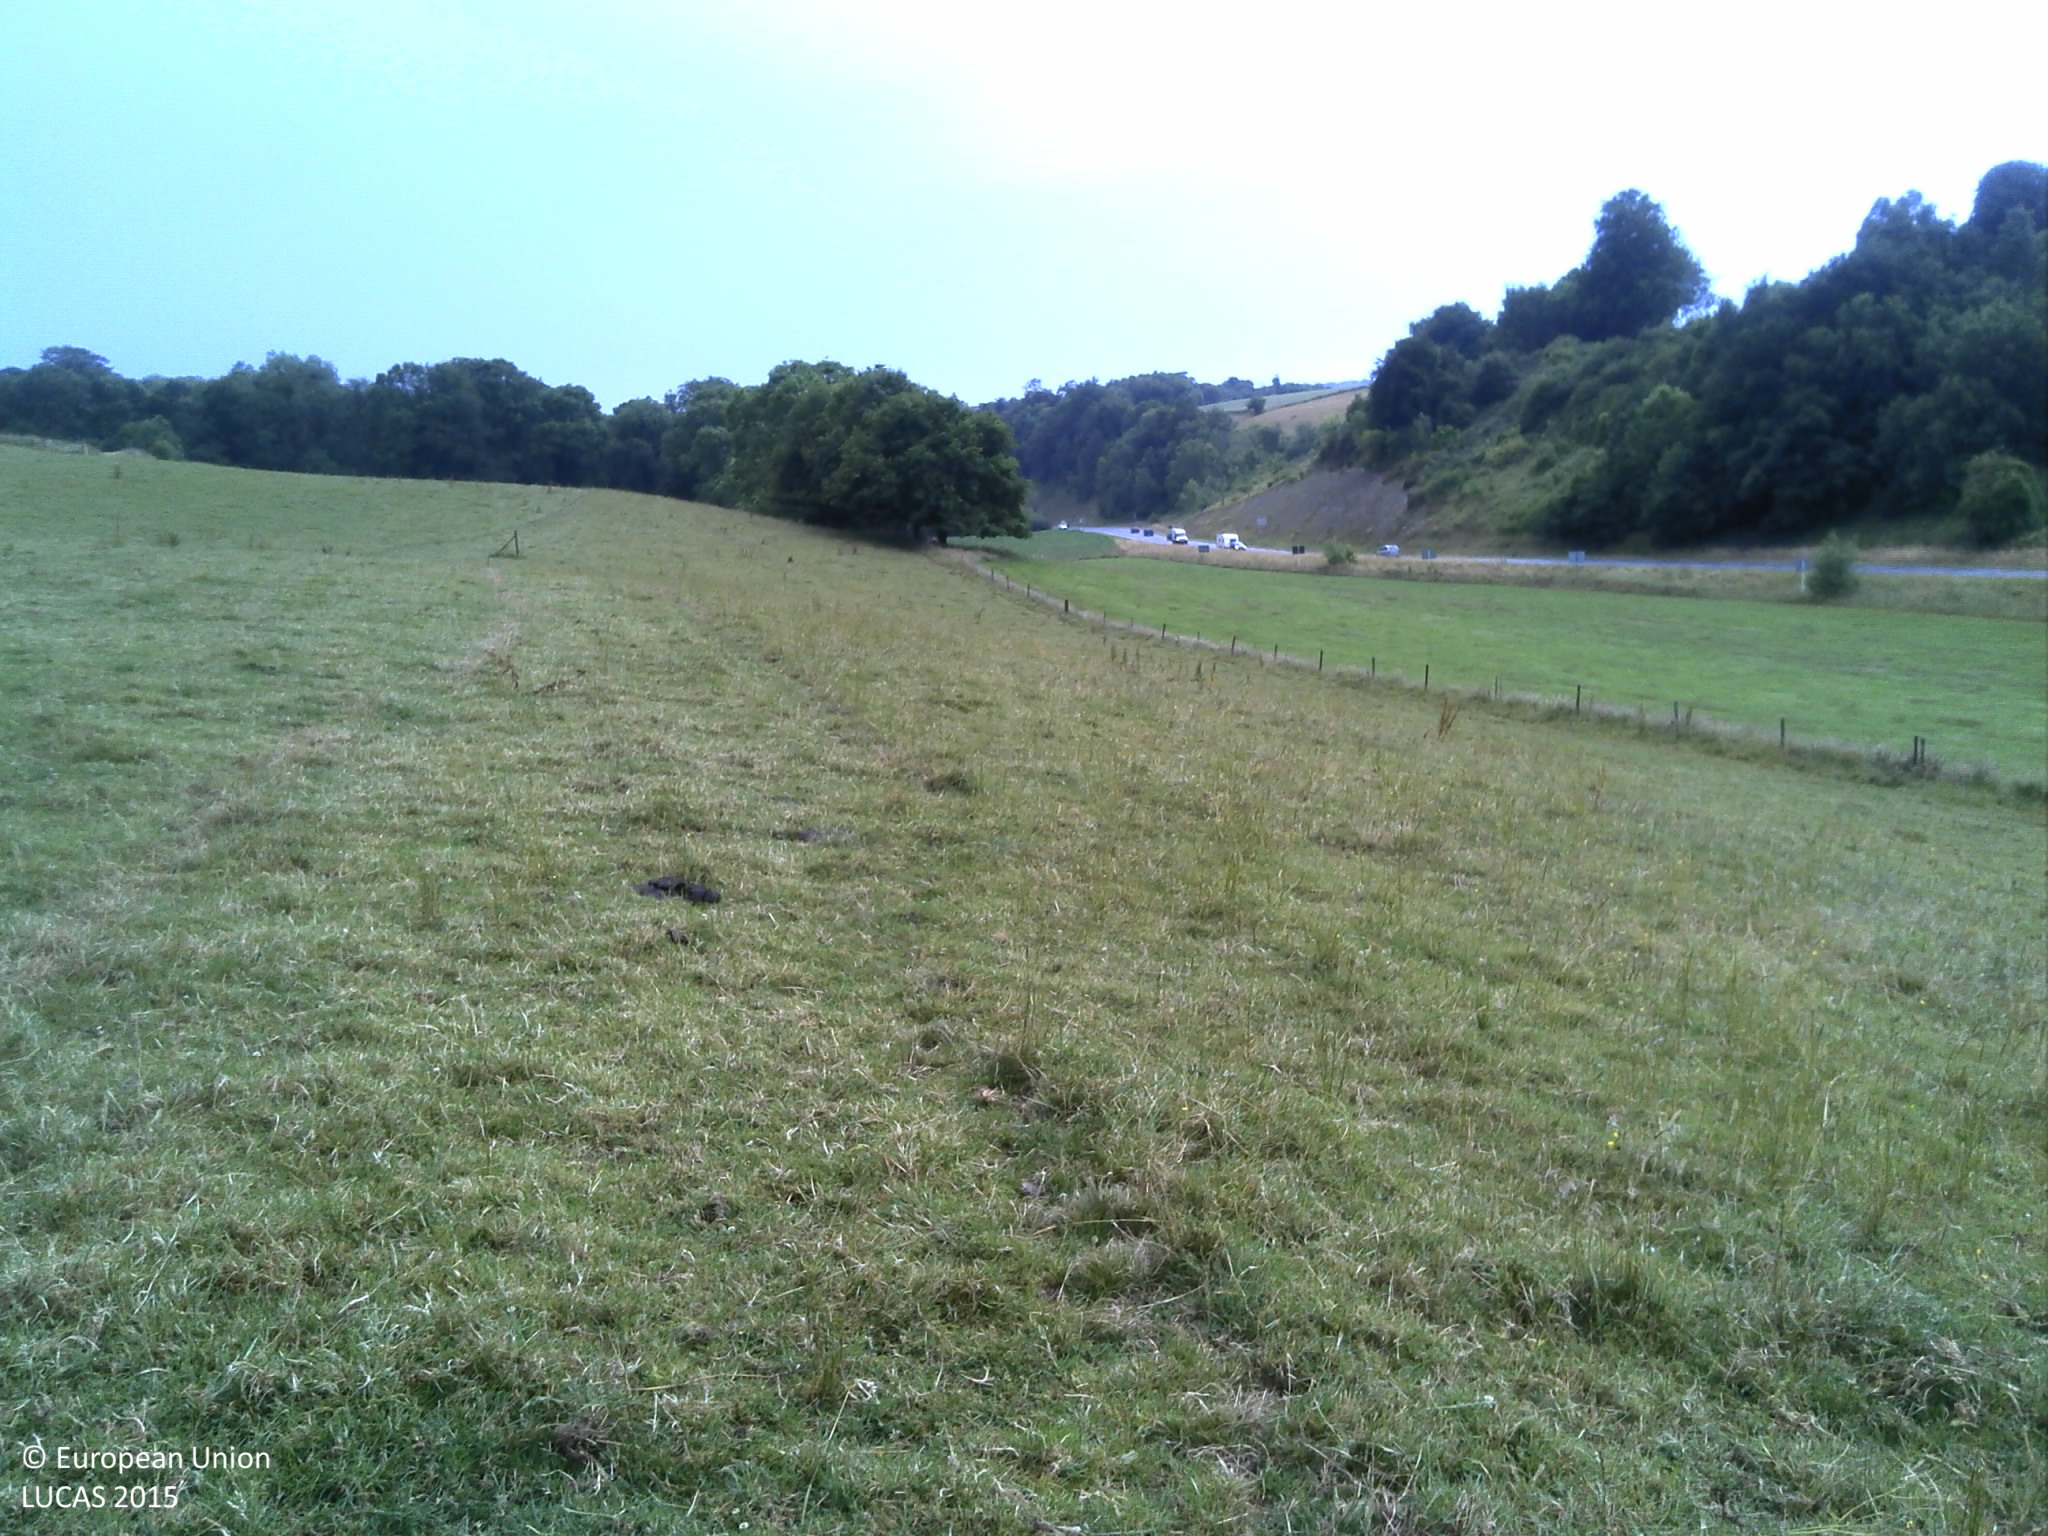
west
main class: Grassland
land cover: Grassland without tree/shrub cover
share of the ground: > 75 %
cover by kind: herbaceous plants 100 %
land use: Agriculture (excluding fallow land and kitchen gardens)
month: July
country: FR
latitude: 49.8708
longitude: 1.0871
